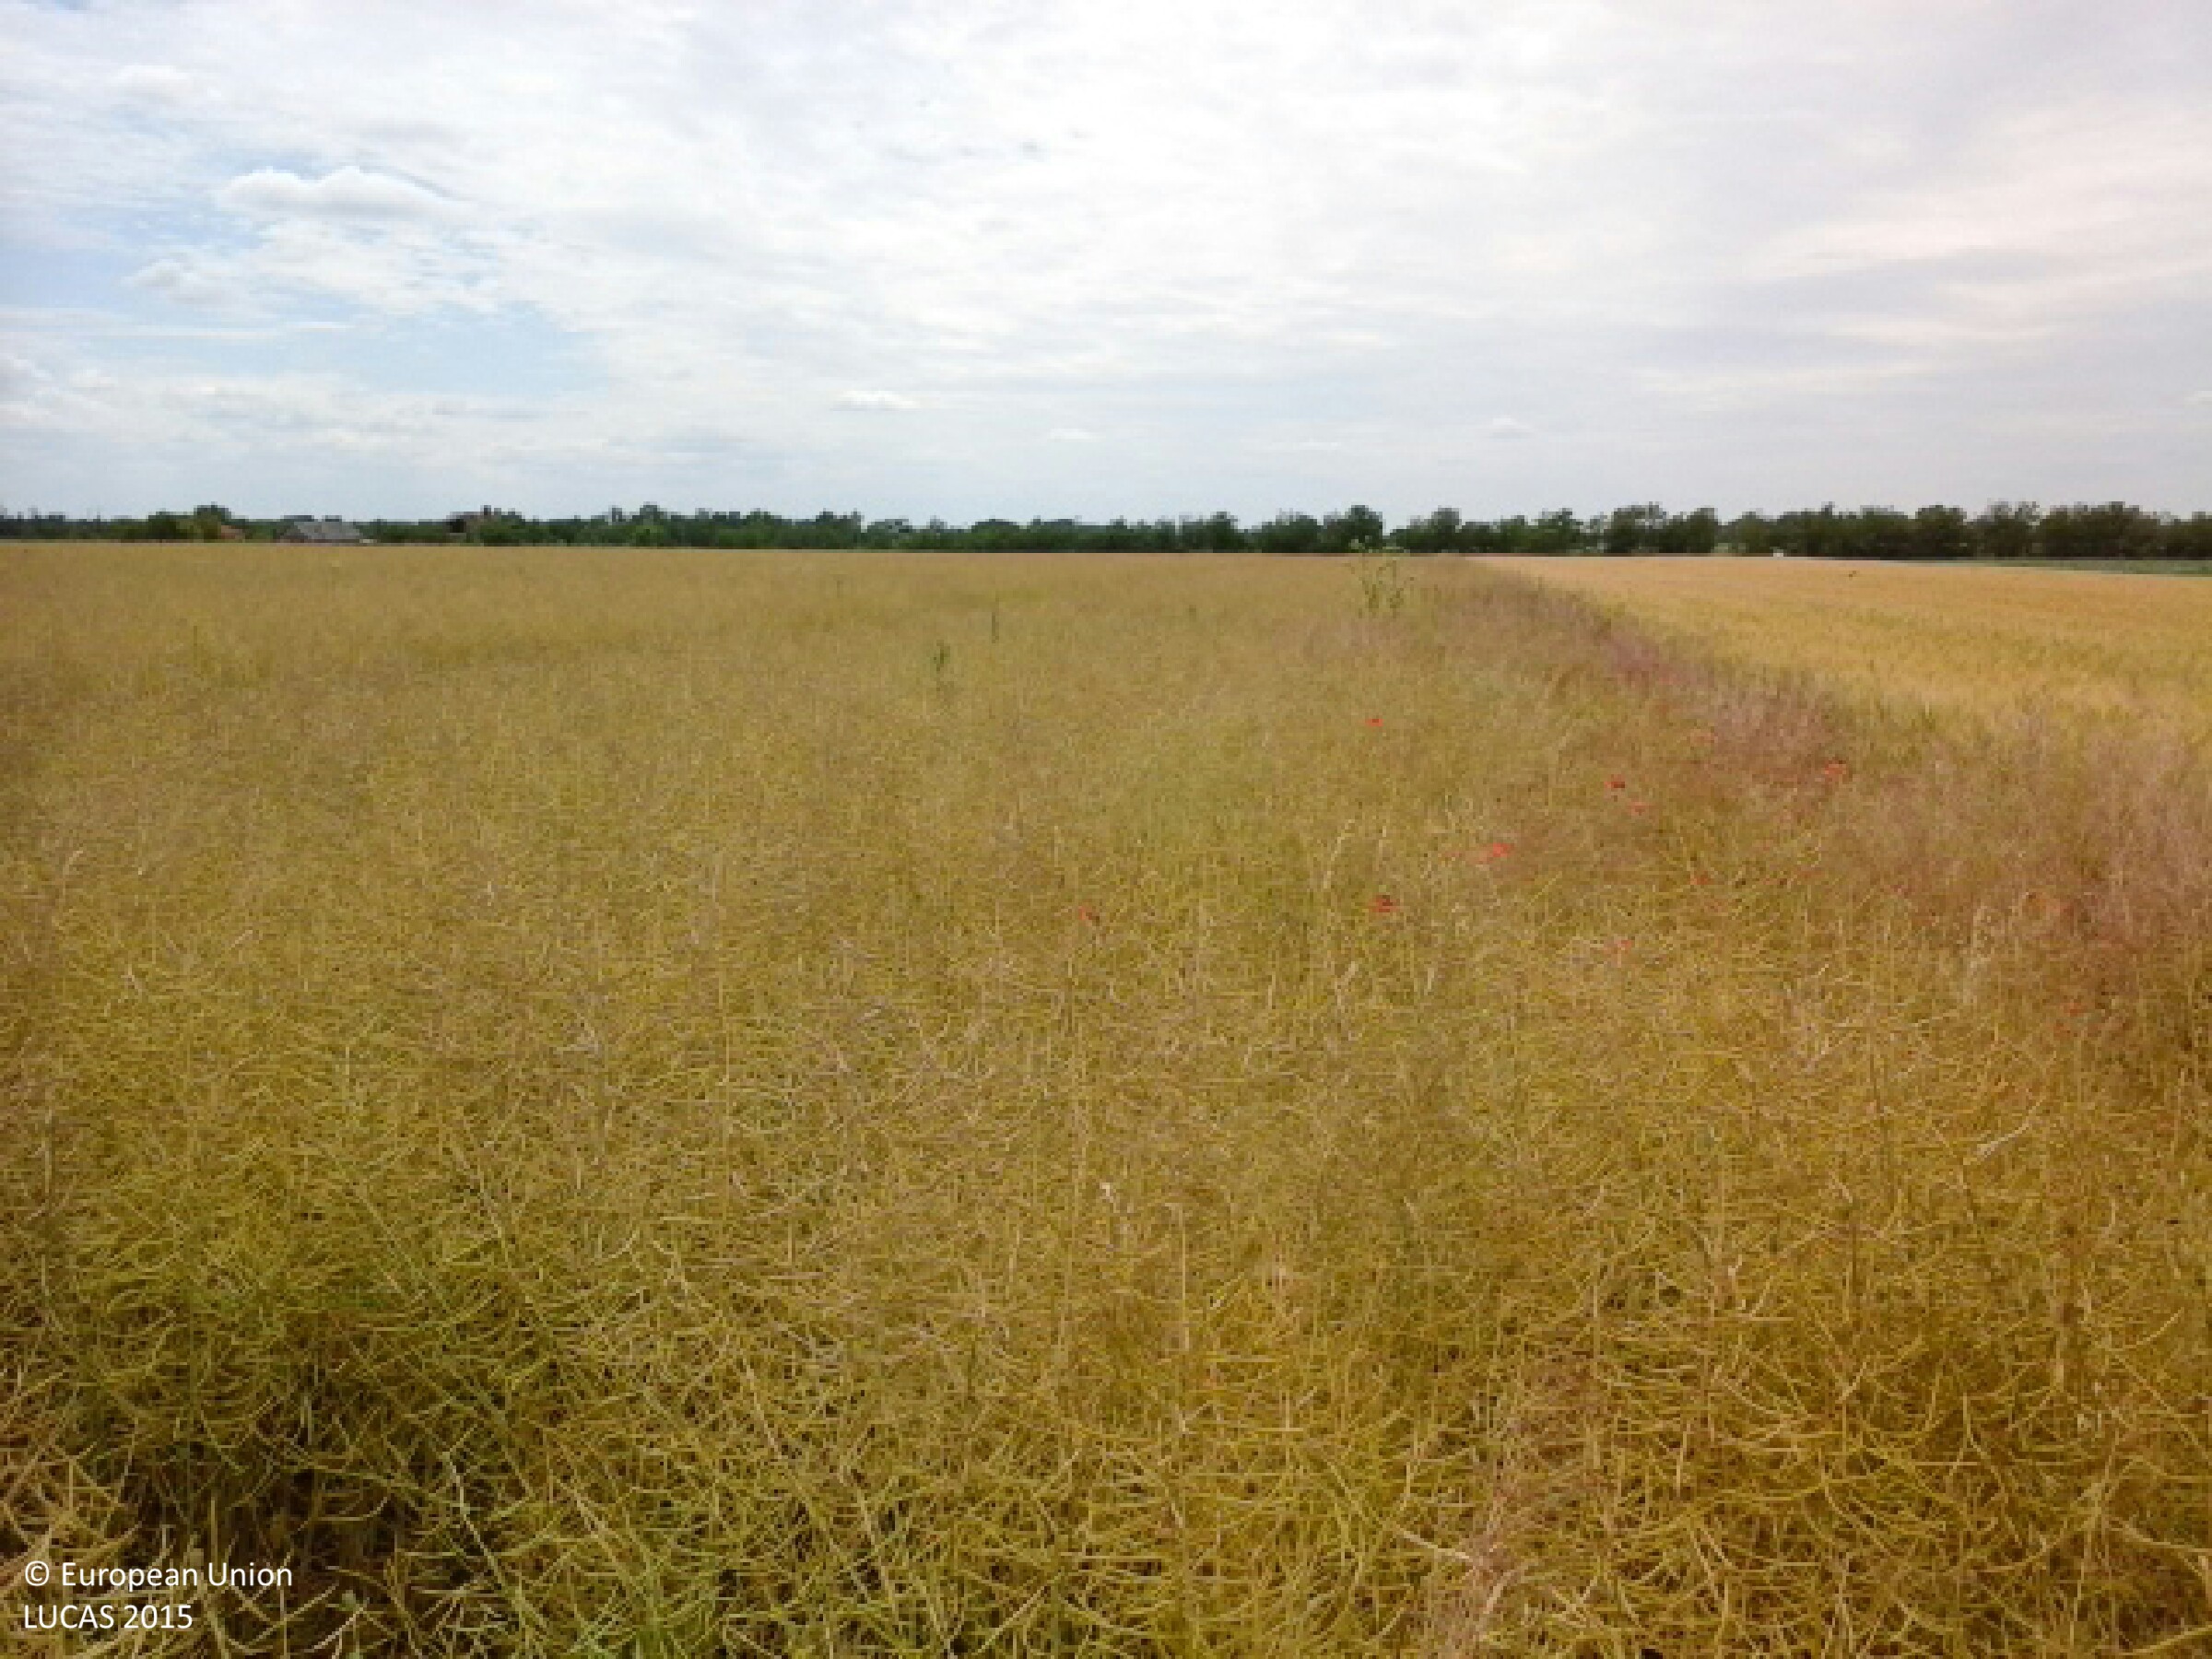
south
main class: Cropland
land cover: Rape and turnip rape
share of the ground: > 75 %
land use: Agriculture (excluding fallow land and kitchen gardens)
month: June
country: HU
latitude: 47.9801
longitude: 21.5270
